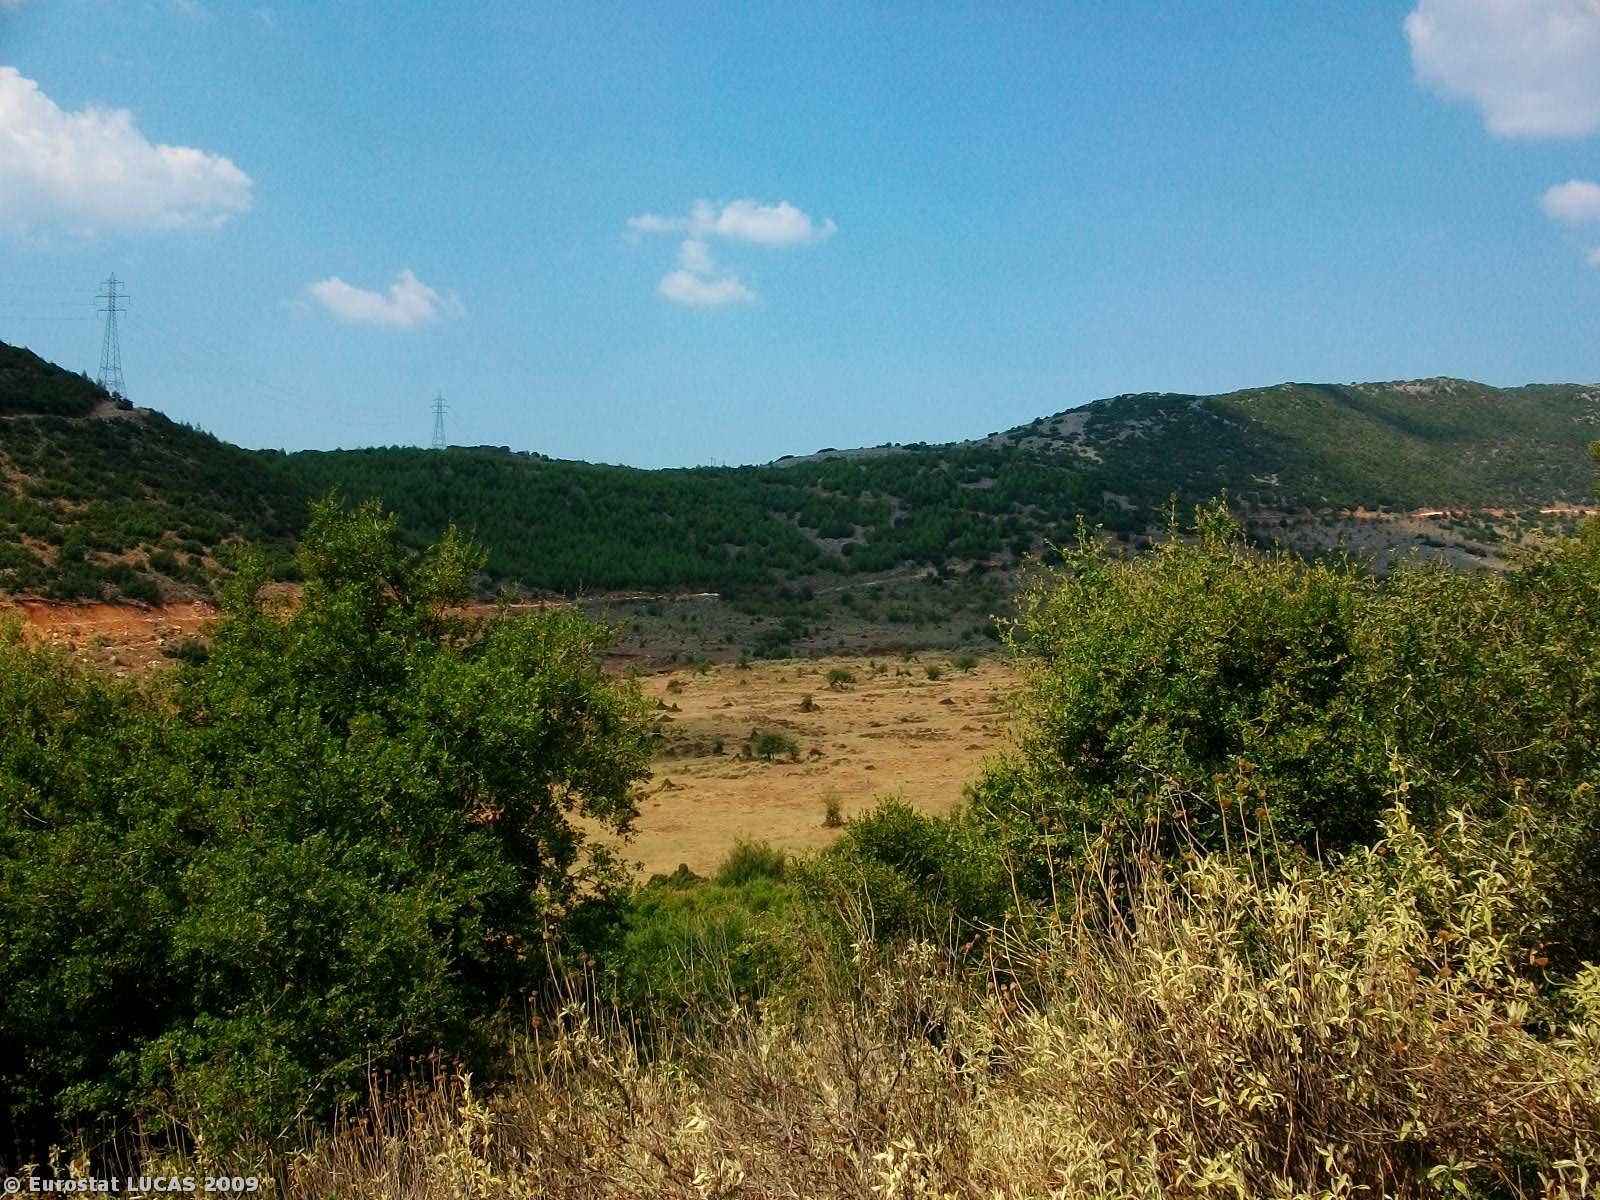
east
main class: Shrubland
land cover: Shrubland with sparse tree cover
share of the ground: > 75 %
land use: Agriculture (excluding fallow land and kitchen gardens)
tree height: < 5 m
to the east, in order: Shrubland with sparse tree cover
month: August
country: GR
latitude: 39.3225
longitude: 20.4705
